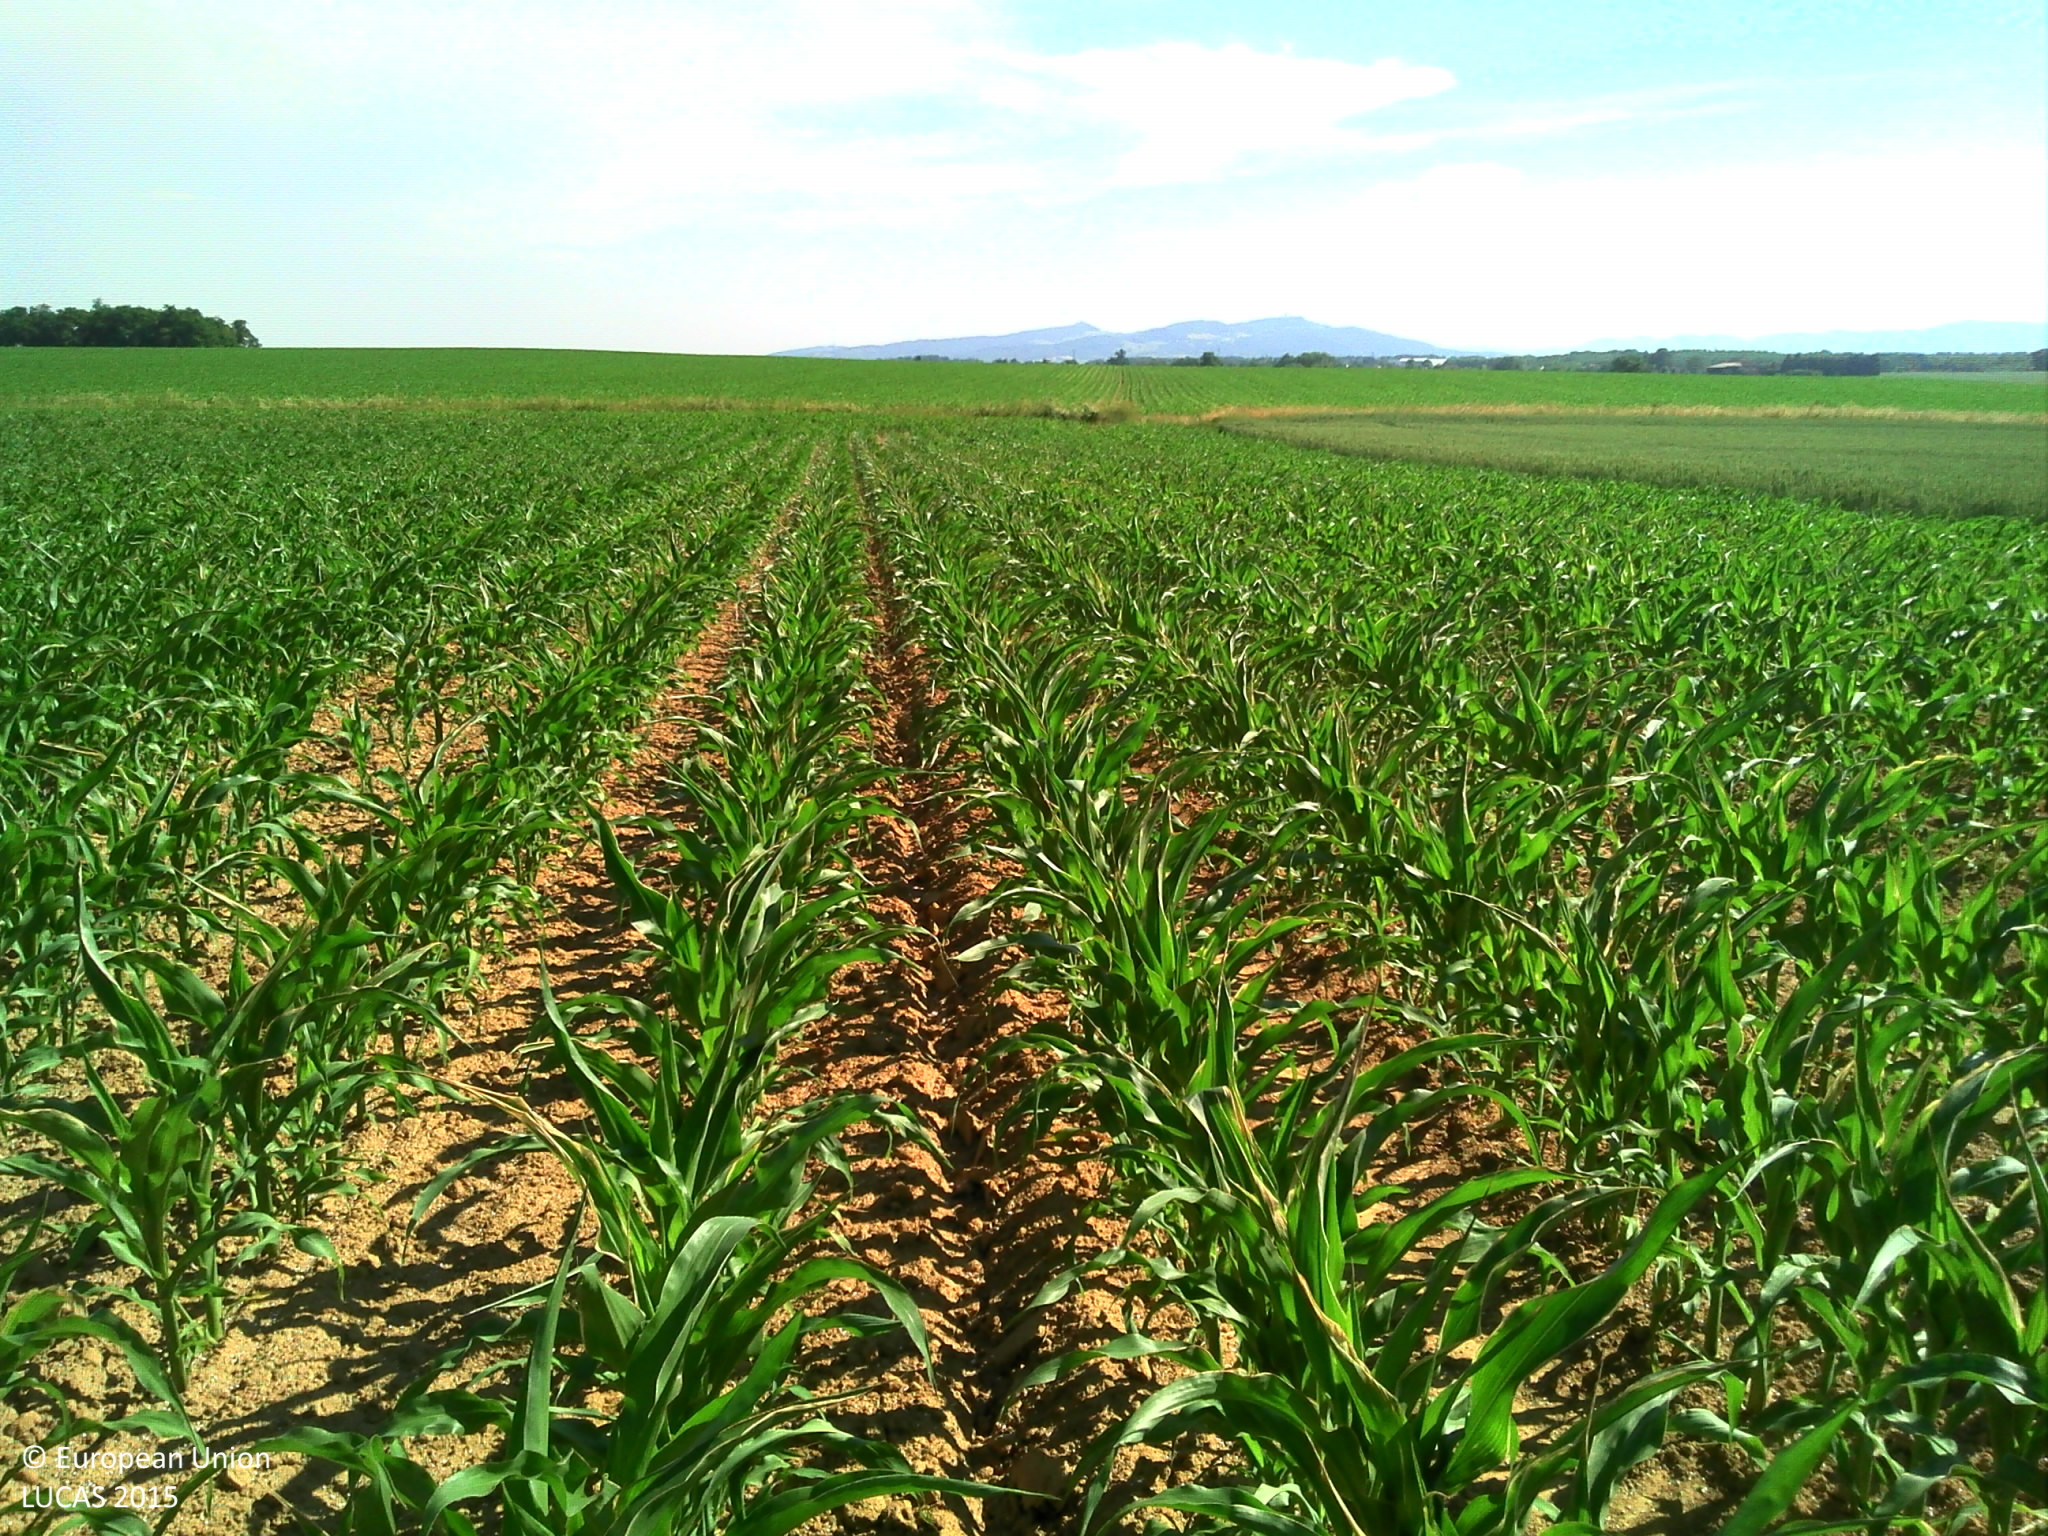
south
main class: Cropland
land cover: Maize
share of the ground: 50 - 75 %
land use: Agriculture (excluding fallow land and kitchen gardens)
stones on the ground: 10 - 25 %
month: June
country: FR
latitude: 45.9734
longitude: 4.8276
